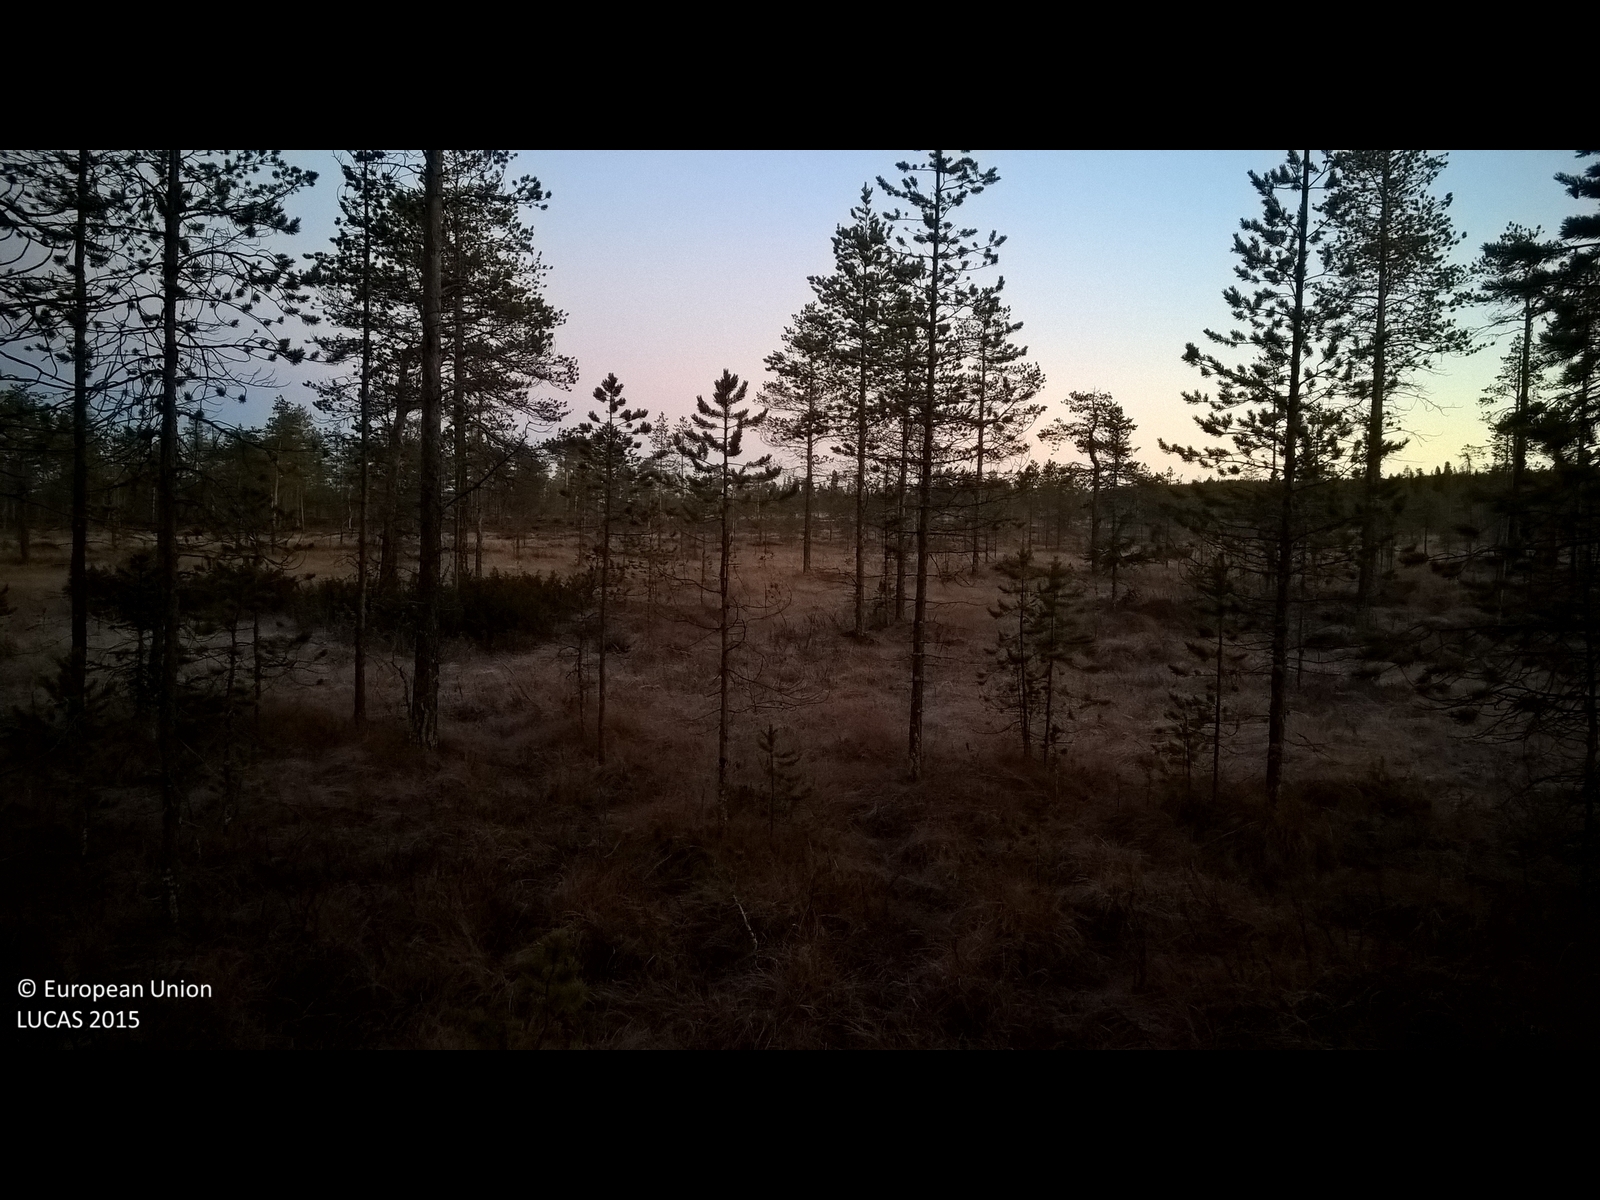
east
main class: Woodland
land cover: Pine dominated coniferous woodland
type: mire and swamp forests
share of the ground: 25 - 50 %
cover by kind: coniferous forest trees 40 %, shrubs 20 %, herbaceous plants 20 %, lichens and mosses 20 %
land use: Forestry
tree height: > 5 m
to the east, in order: Pine dominated coniferous woodland; Peatbogs; Pine dominated coniferous woodland; Peatbogs
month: November
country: SE
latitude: 62.3509
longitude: 13.6738
